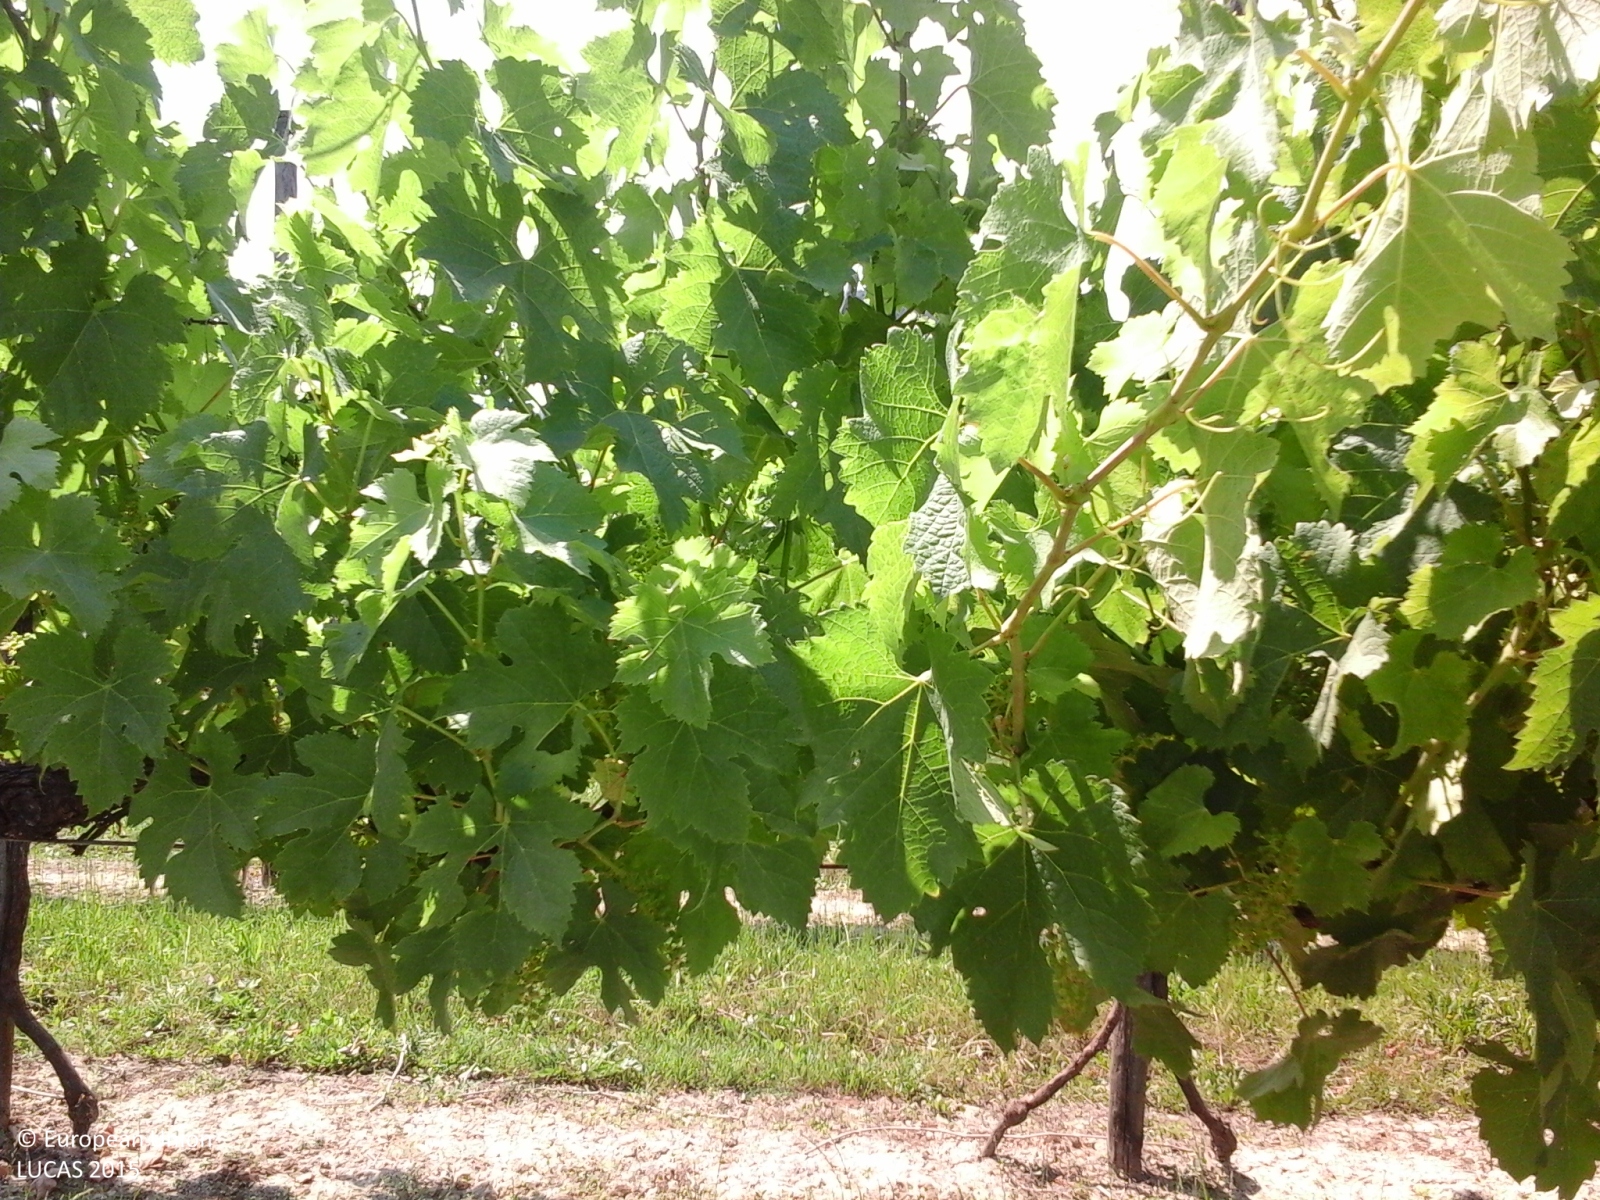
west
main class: Cropland
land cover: Vineyards
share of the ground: 50 - 75 %
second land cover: Grassland without tree/shrub cover
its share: > 75 %
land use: Agriculture (excluding fallow land and kitchen gardens)
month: June
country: IT
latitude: 45.3462
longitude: 11.7201
